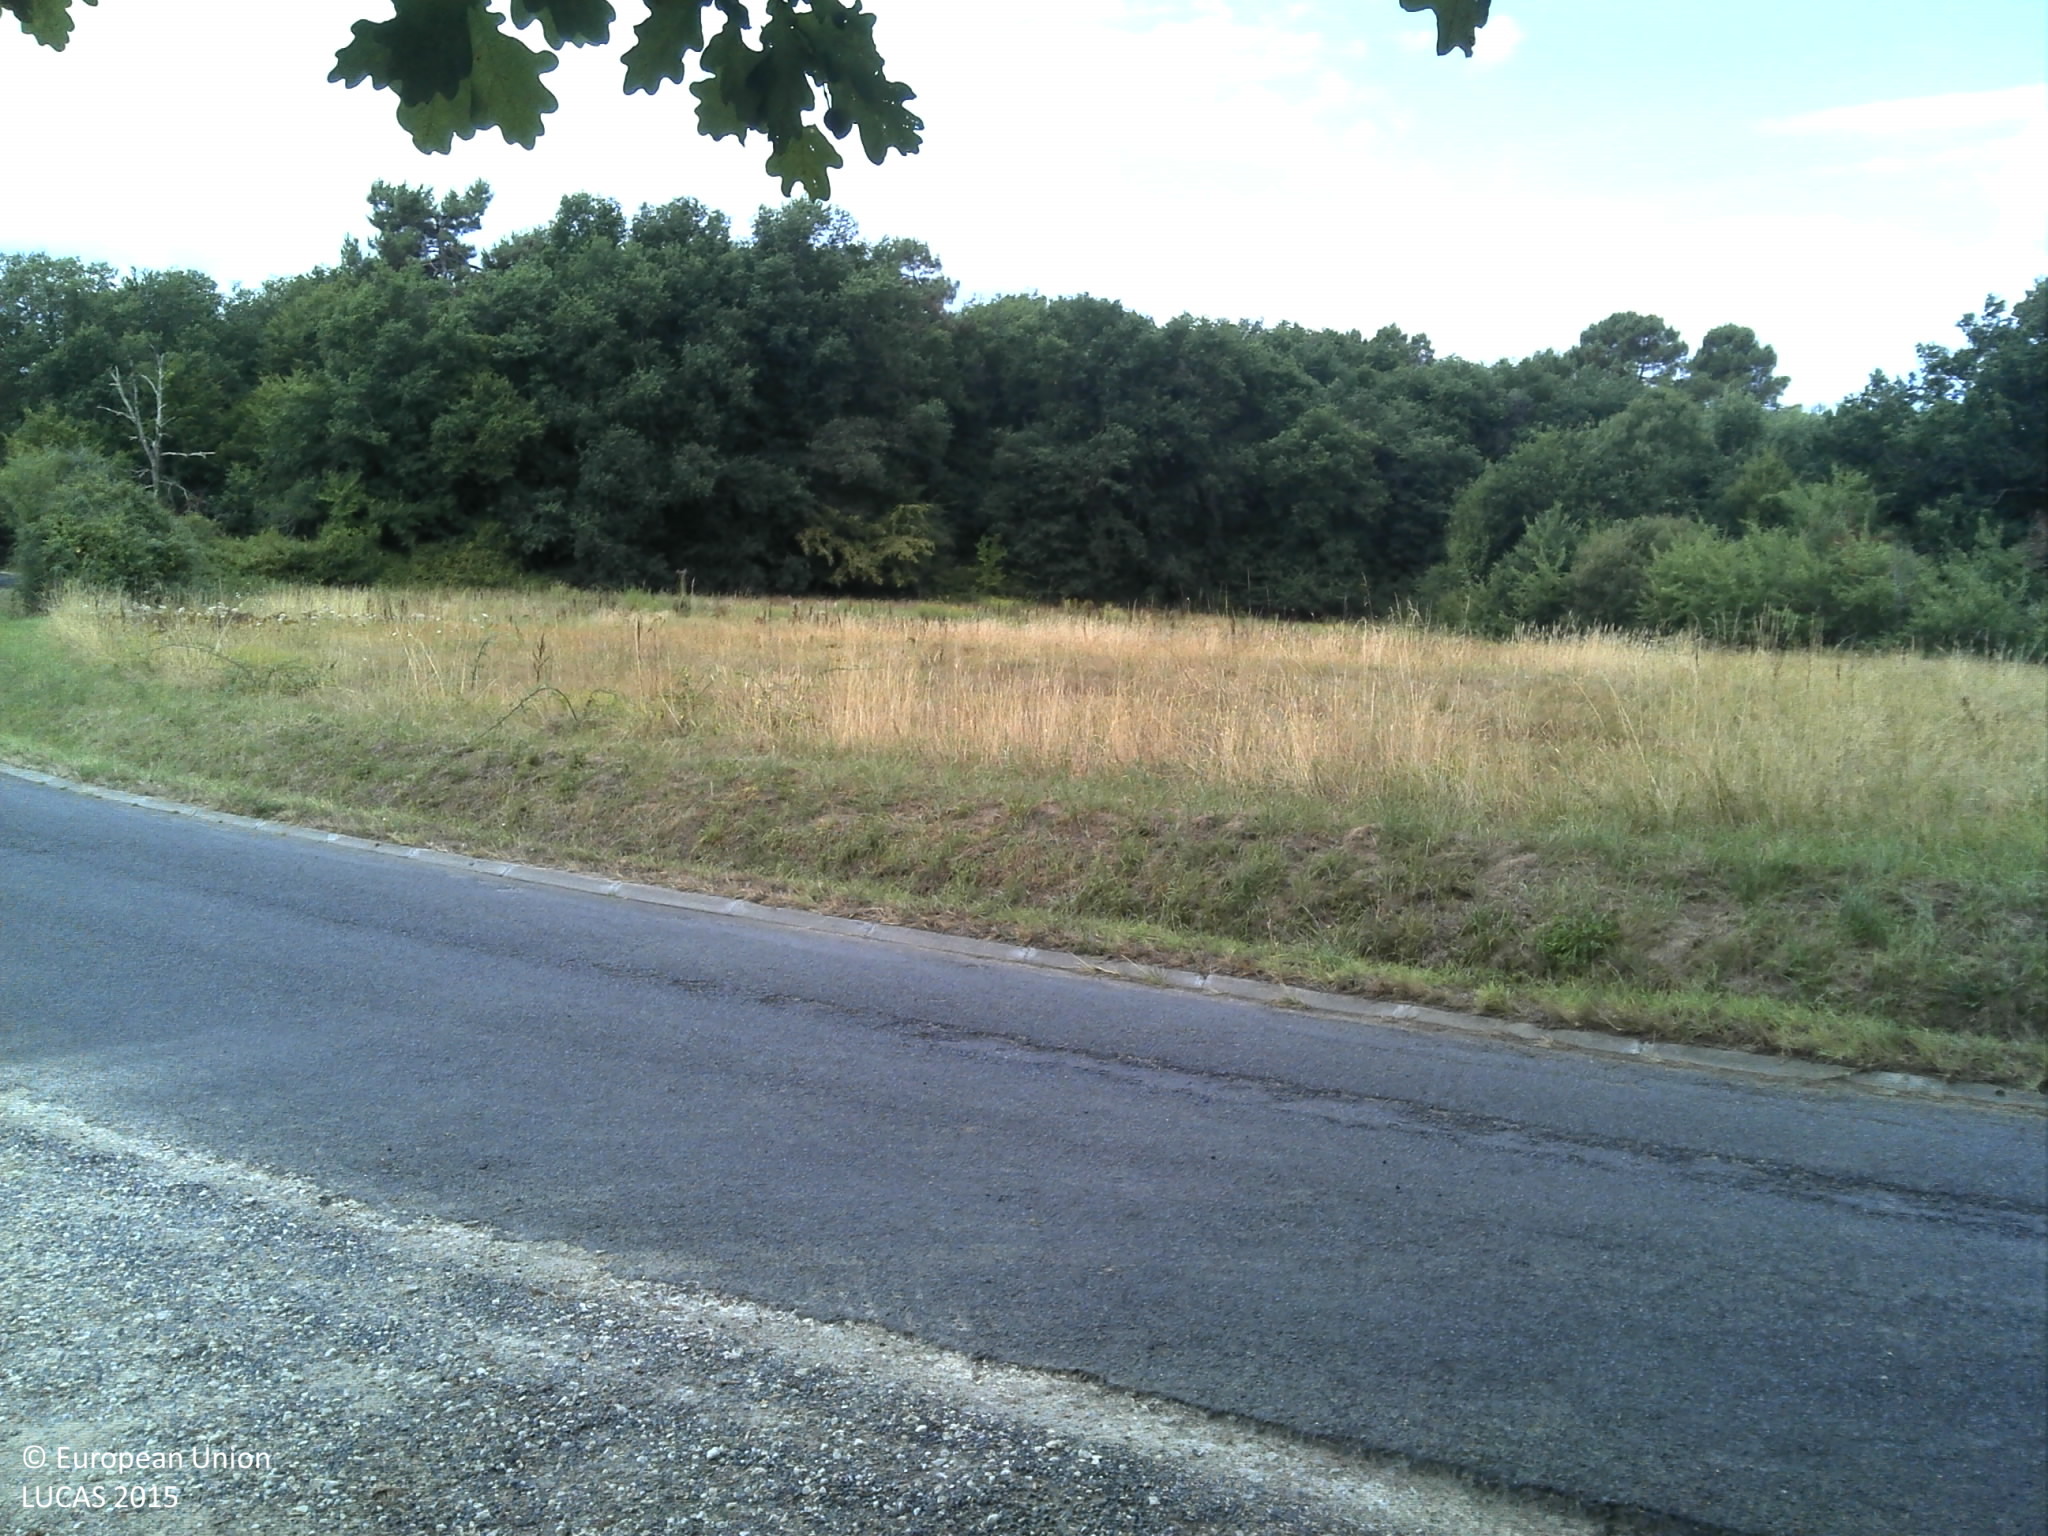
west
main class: Woodland
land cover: Broadleaved woodland
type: thermophilous deciduous forest
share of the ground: > 75 %
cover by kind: broadleaved forest trees 100 %
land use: Forestry
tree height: > 5 m
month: July
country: FR
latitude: 44.8055
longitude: -0.4222
